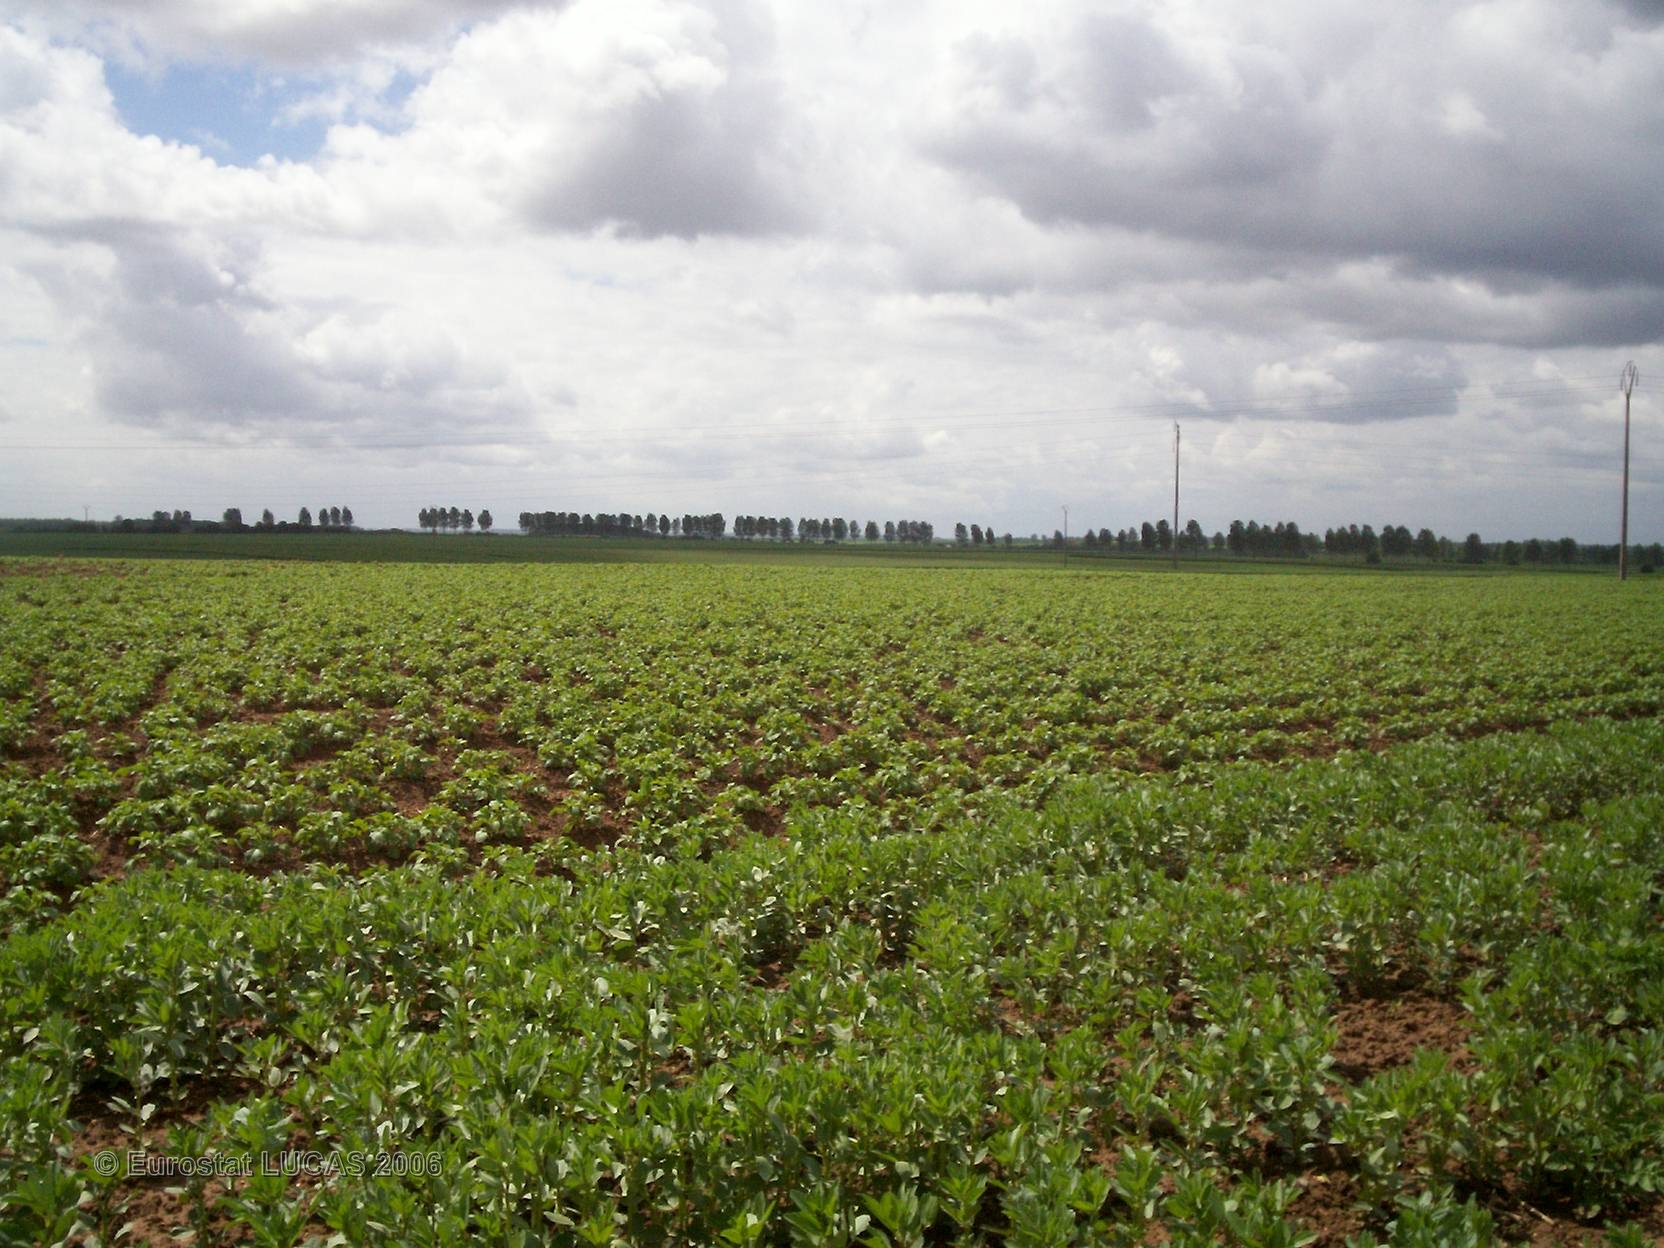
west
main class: Cropland
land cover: Dry pulses
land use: Agriculture (excluding fallow land and kitchen gardens)
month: May
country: FR
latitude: 49.8410
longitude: 2.6885
